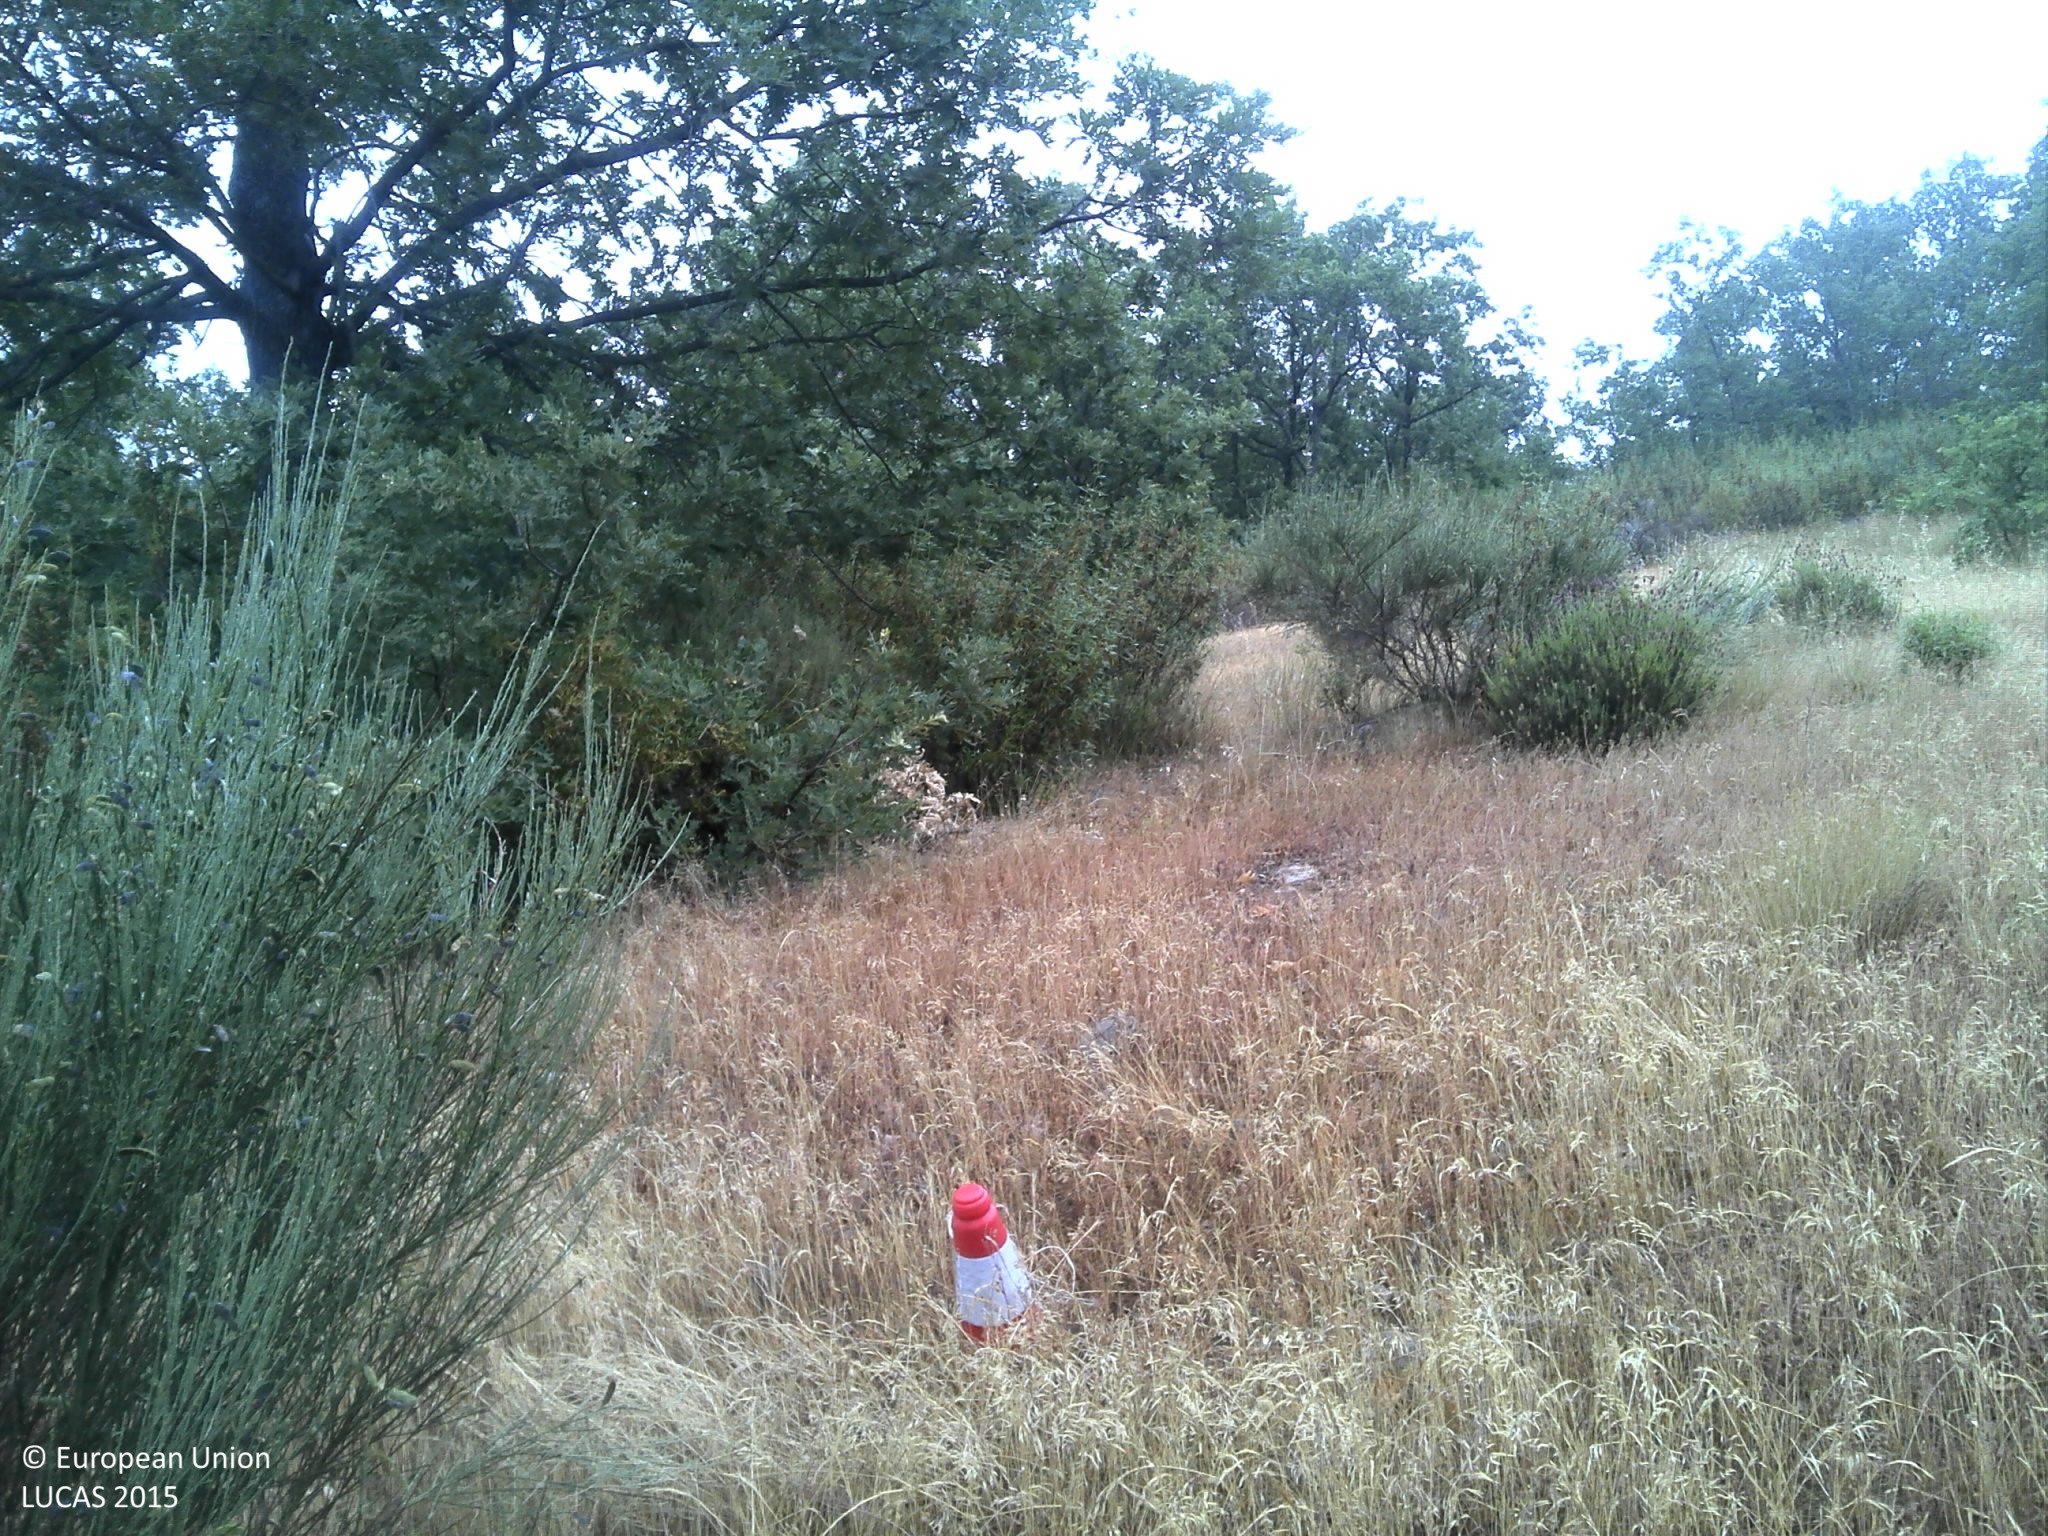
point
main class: Woodland
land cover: Broadleaved woodland
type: acidophilous oak and oak-birch forest
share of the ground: 25 - 50 %
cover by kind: broadleaved forest trees 35 %, herbaceous plants 30 %, unconsolidated bare surface 20 %, shrubs 15 %
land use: Forestry
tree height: > 5 m
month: June
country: PT
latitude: 40.1979
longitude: -7.4795
